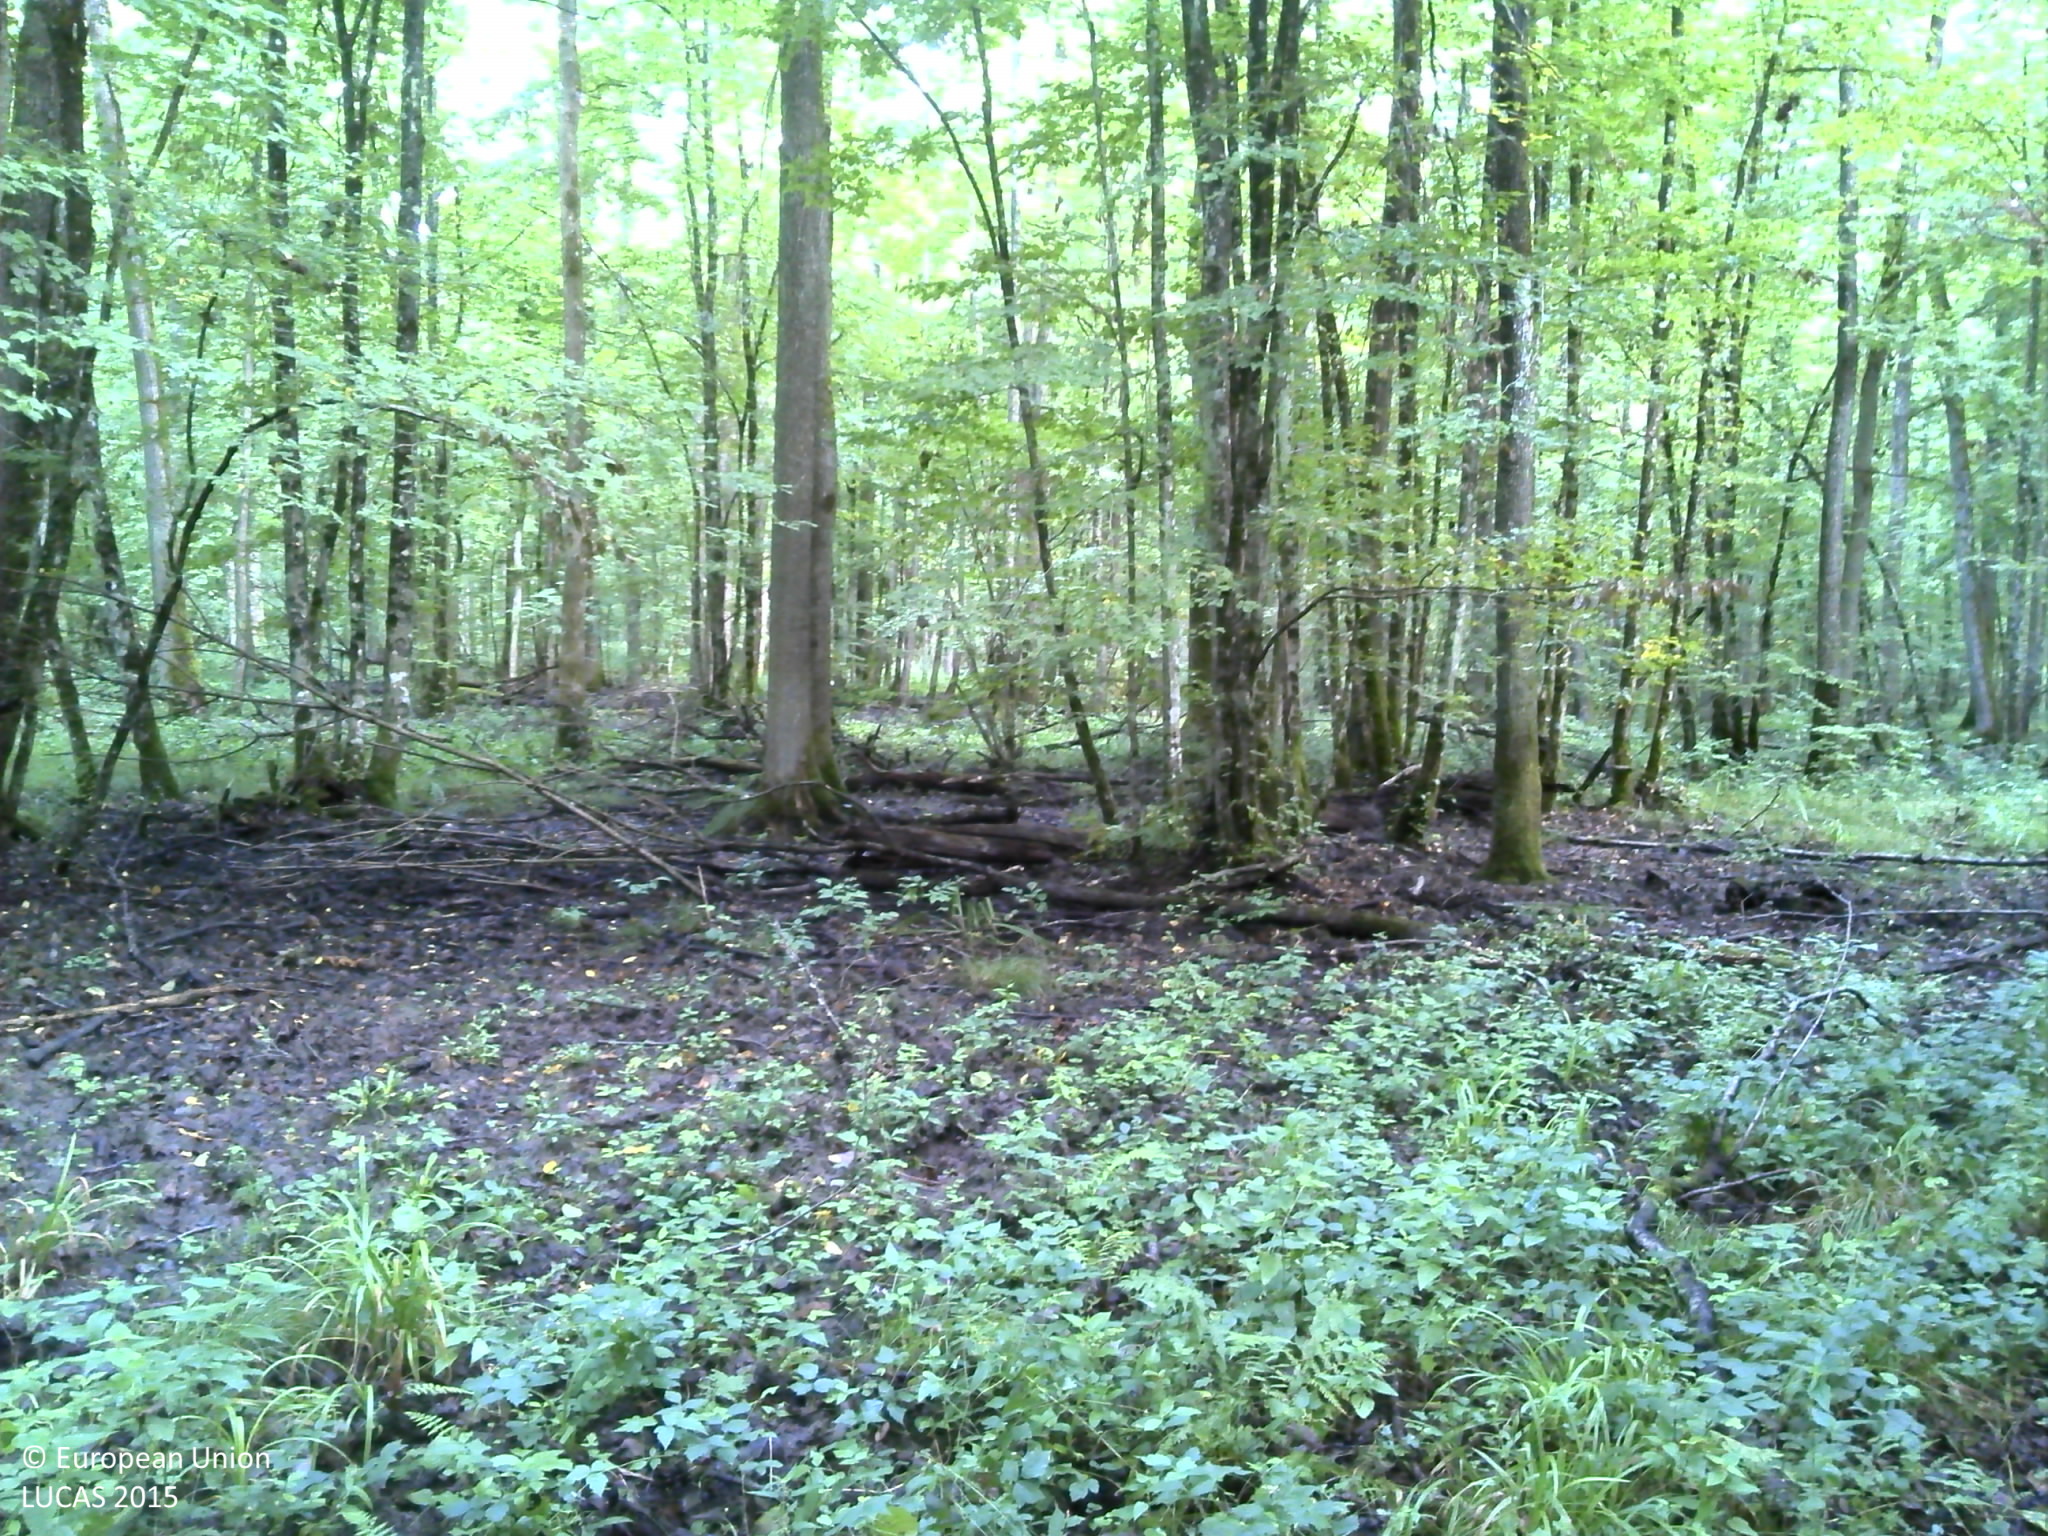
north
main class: Woodland
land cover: Broadleaved woodland
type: mesophytic deciduous forest
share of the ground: > 75 %
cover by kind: broadleaved forest trees 100 %
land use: Forestry
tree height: > 5 m
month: August
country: HR
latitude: 45.5866
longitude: 15.6748
